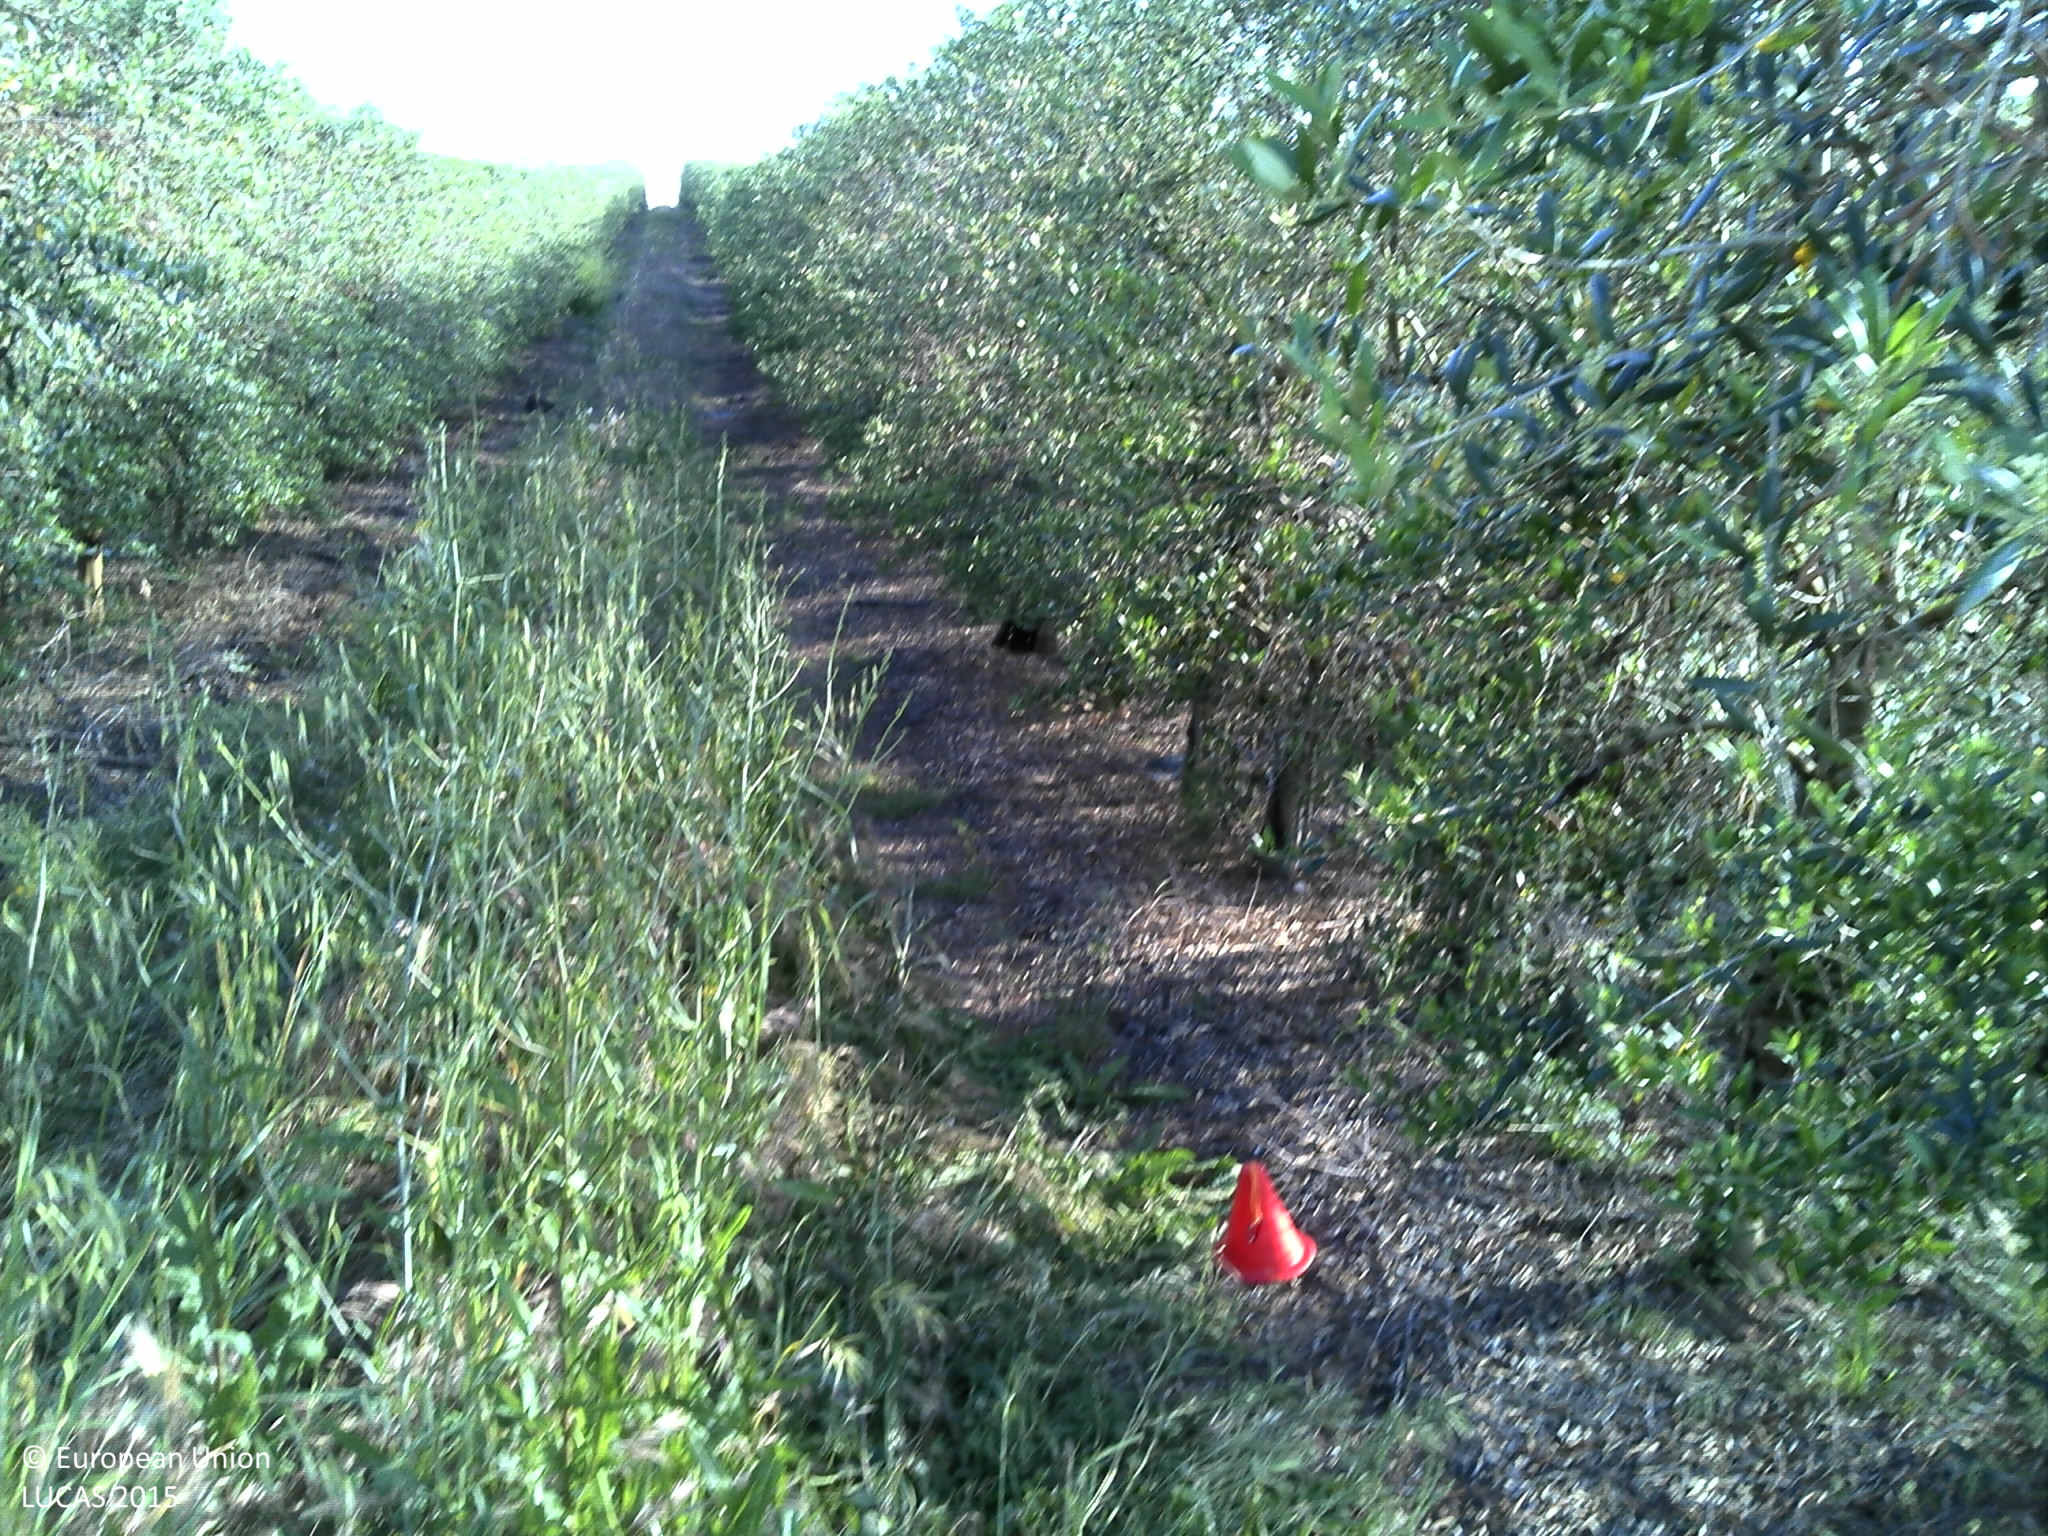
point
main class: Cropland
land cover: Olive groves
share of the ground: 25 - 50 %
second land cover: Grassland without tree/shrub cover
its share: 25 - 50 %
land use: Agriculture (excluding fallow land and kitchen gardens)
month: May
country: PT
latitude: 39.0445
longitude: -7.8280
